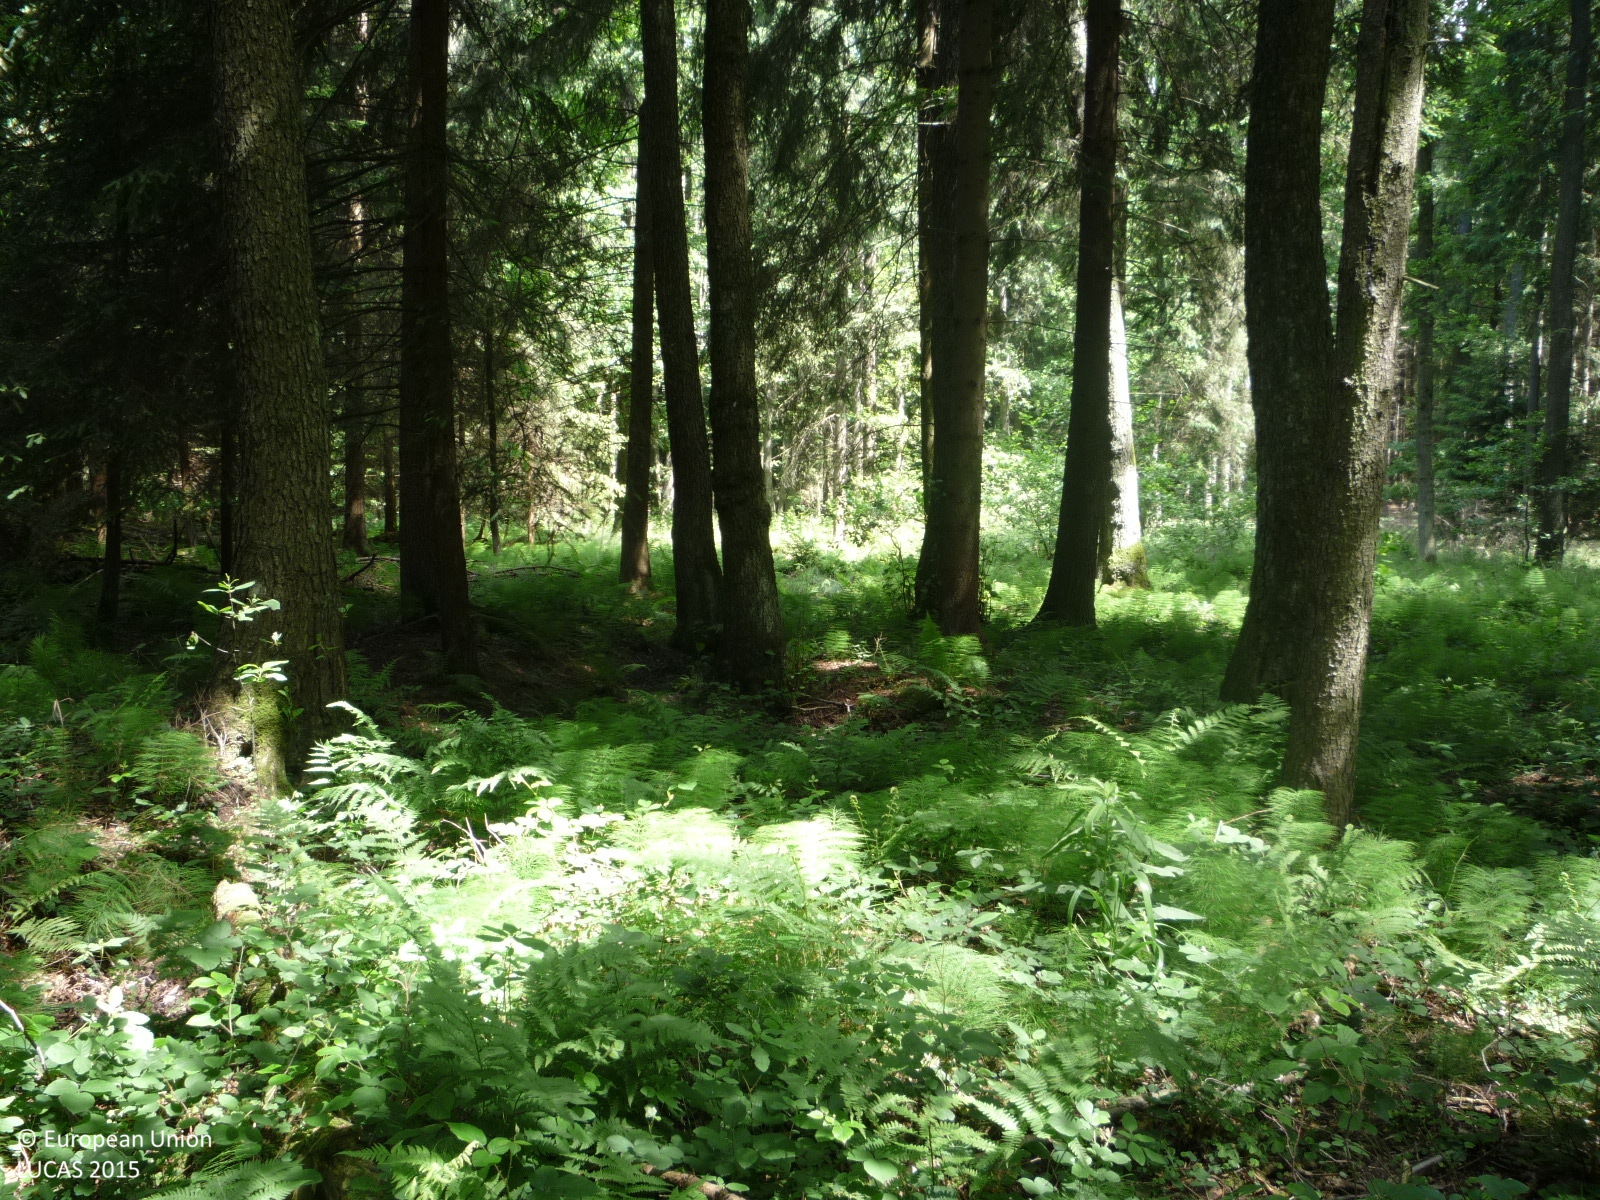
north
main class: Woodland
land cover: Spruce dominated mixed woodland
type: hemiboreal forest and nemoral coniferous forest and mixed broadleaved-coniferous forest
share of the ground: > 75 %
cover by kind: coniferous forest trees 60 %, broadleaved forest trees 25 %, herbaceous plants 15 %
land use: Forestry
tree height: > 5 m
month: June
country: CZ
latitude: 49.7942
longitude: 15.6026
